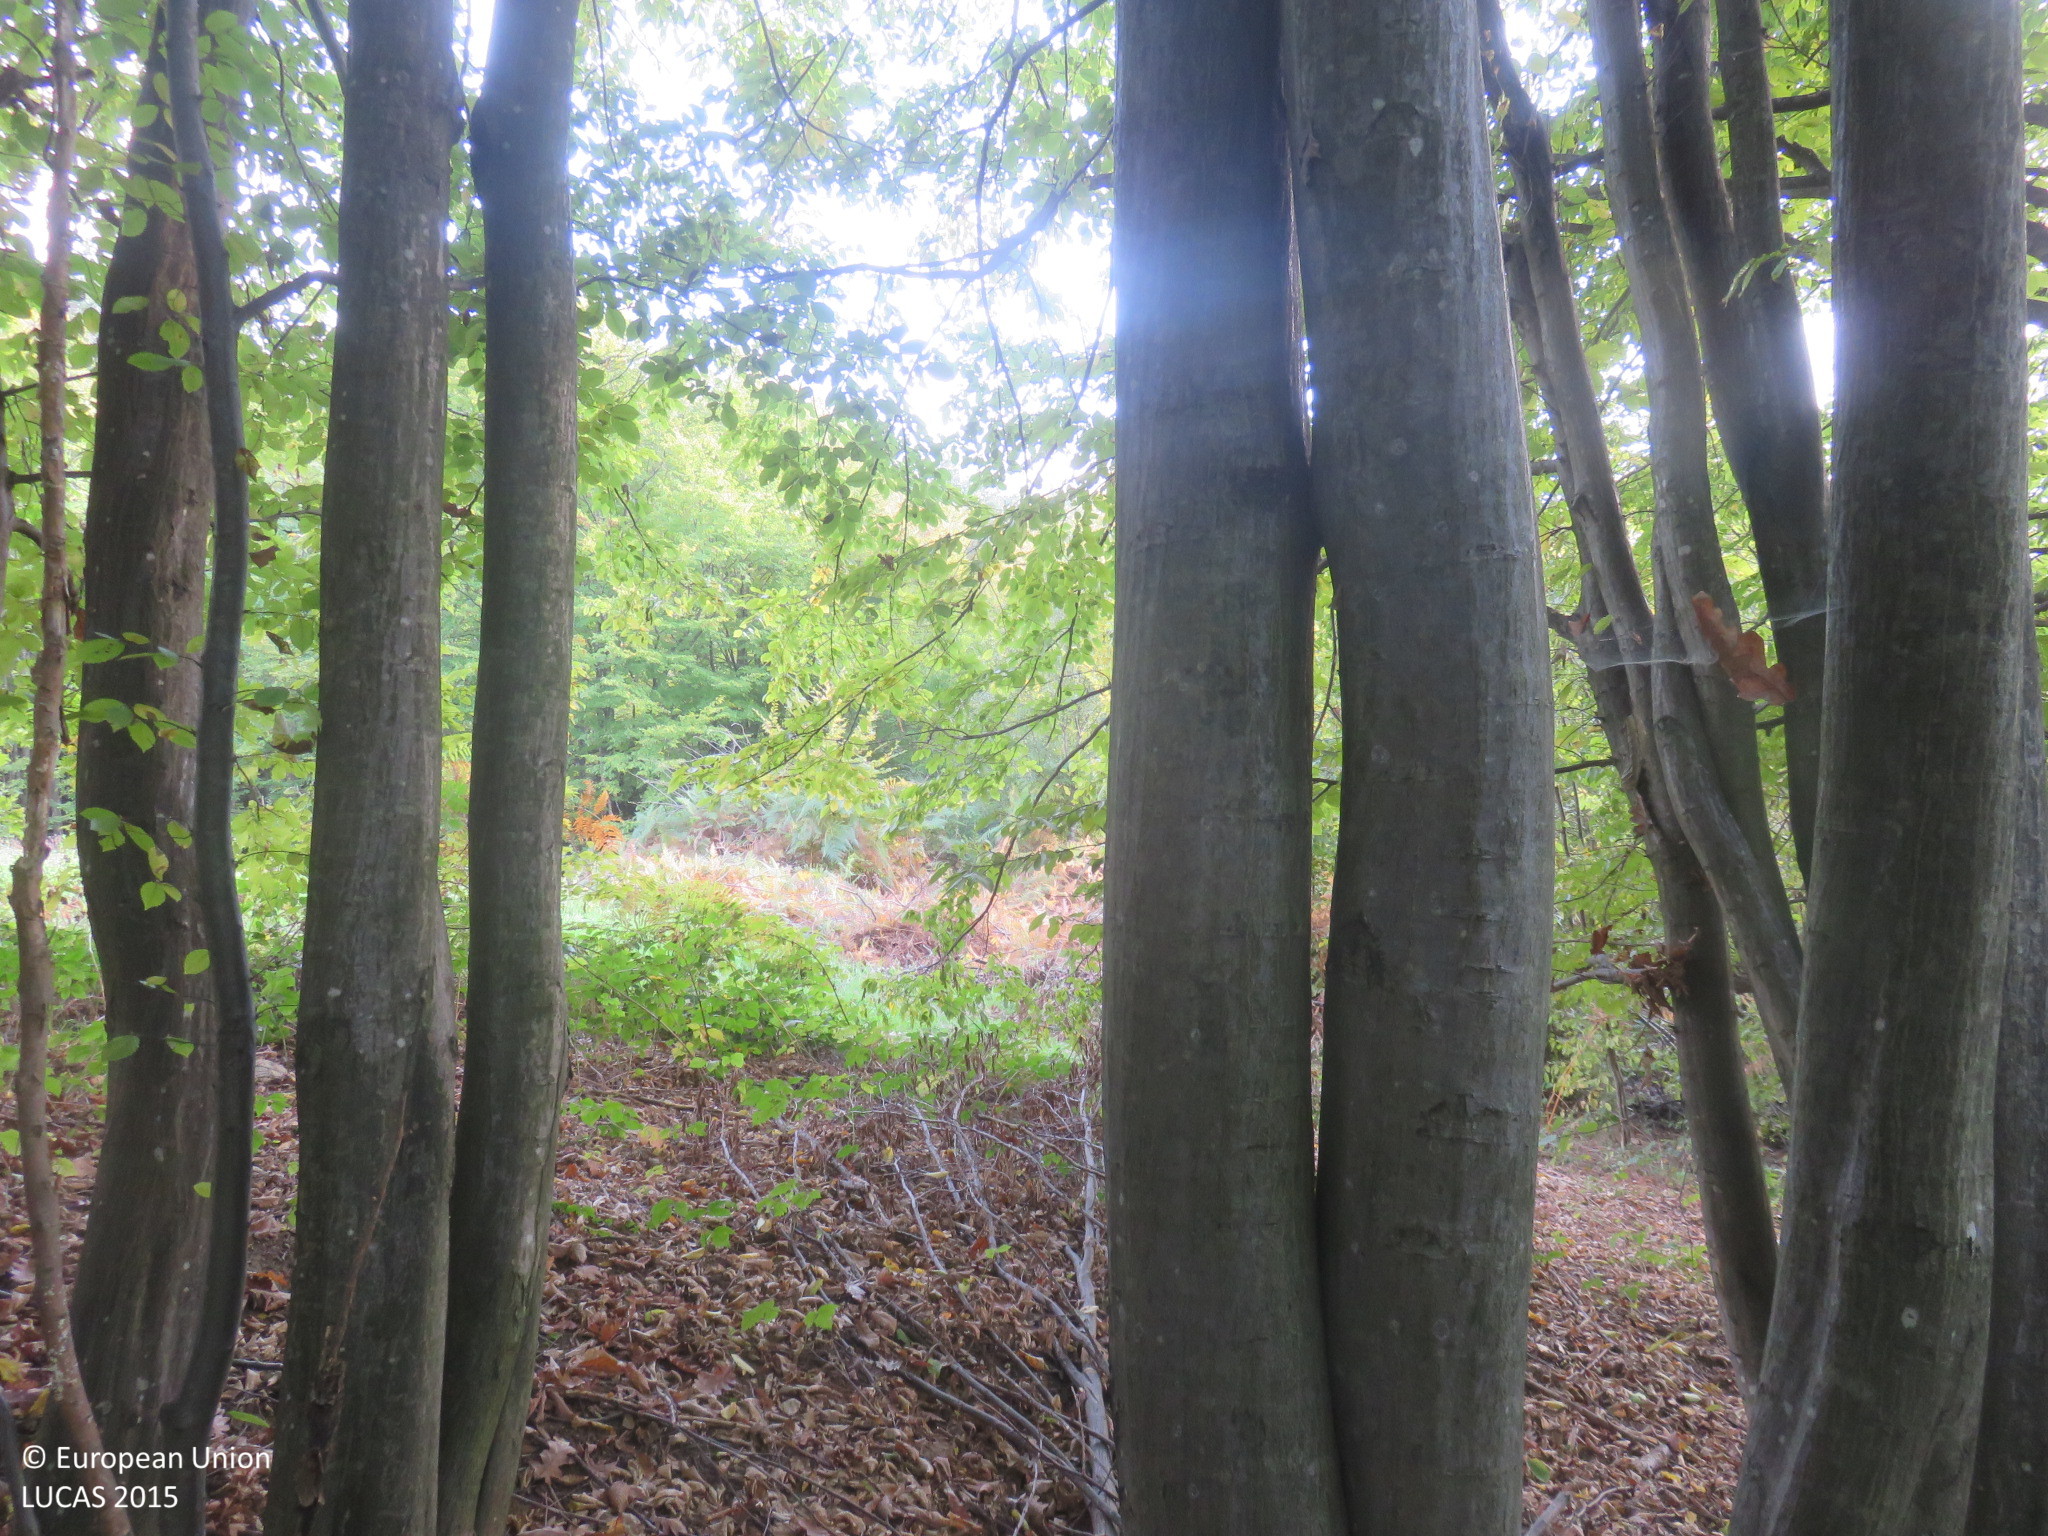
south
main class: Woodland
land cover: Broadleaved woodland
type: beech forest
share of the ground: > 75 %
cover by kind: broadleaved forest trees 95 %, shrubs 5 %
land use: Forestry
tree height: > 5 m
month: October
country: BG
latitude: 42.8384
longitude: 24.9528
